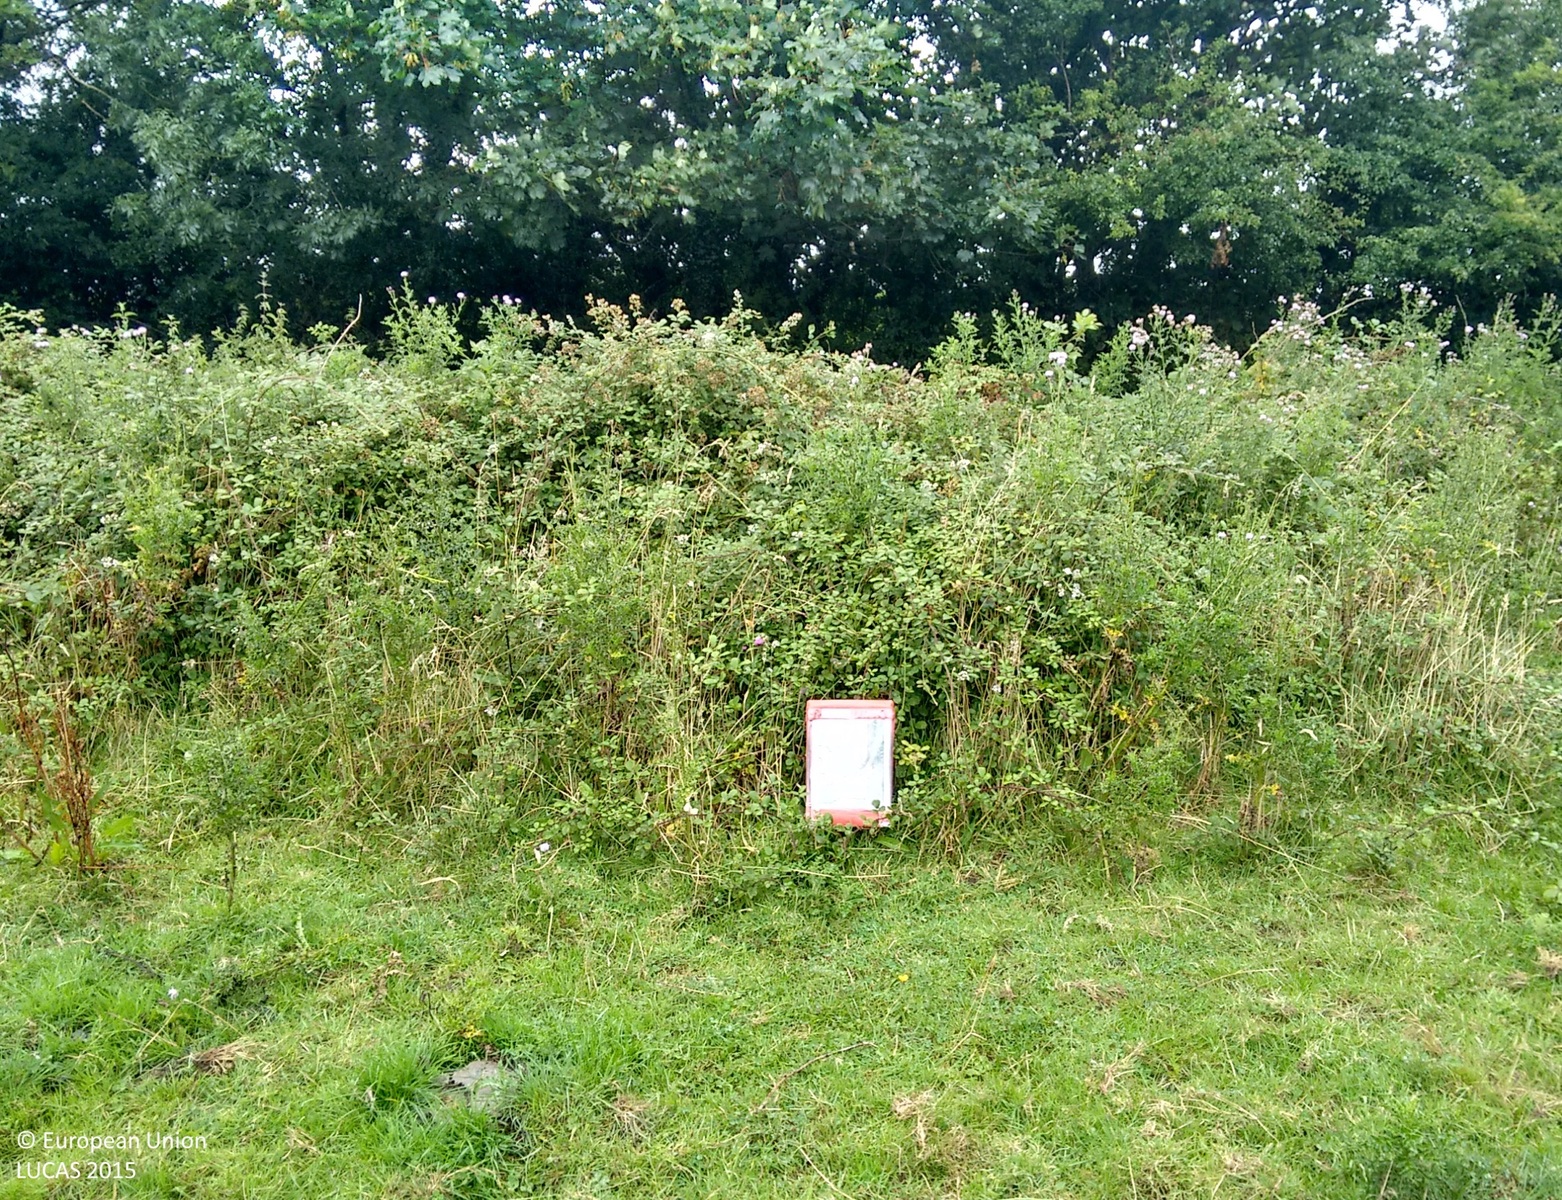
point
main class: Shrubland
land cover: Shrubland with sparse tree cover
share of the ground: > 75 %
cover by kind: shrubs 95 %, broadleaved forest trees 5 %
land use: Agriculture (excluding fallow land and kitchen gardens)
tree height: < 5 m
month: August
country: GB
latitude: 53.1373
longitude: -4.2555
